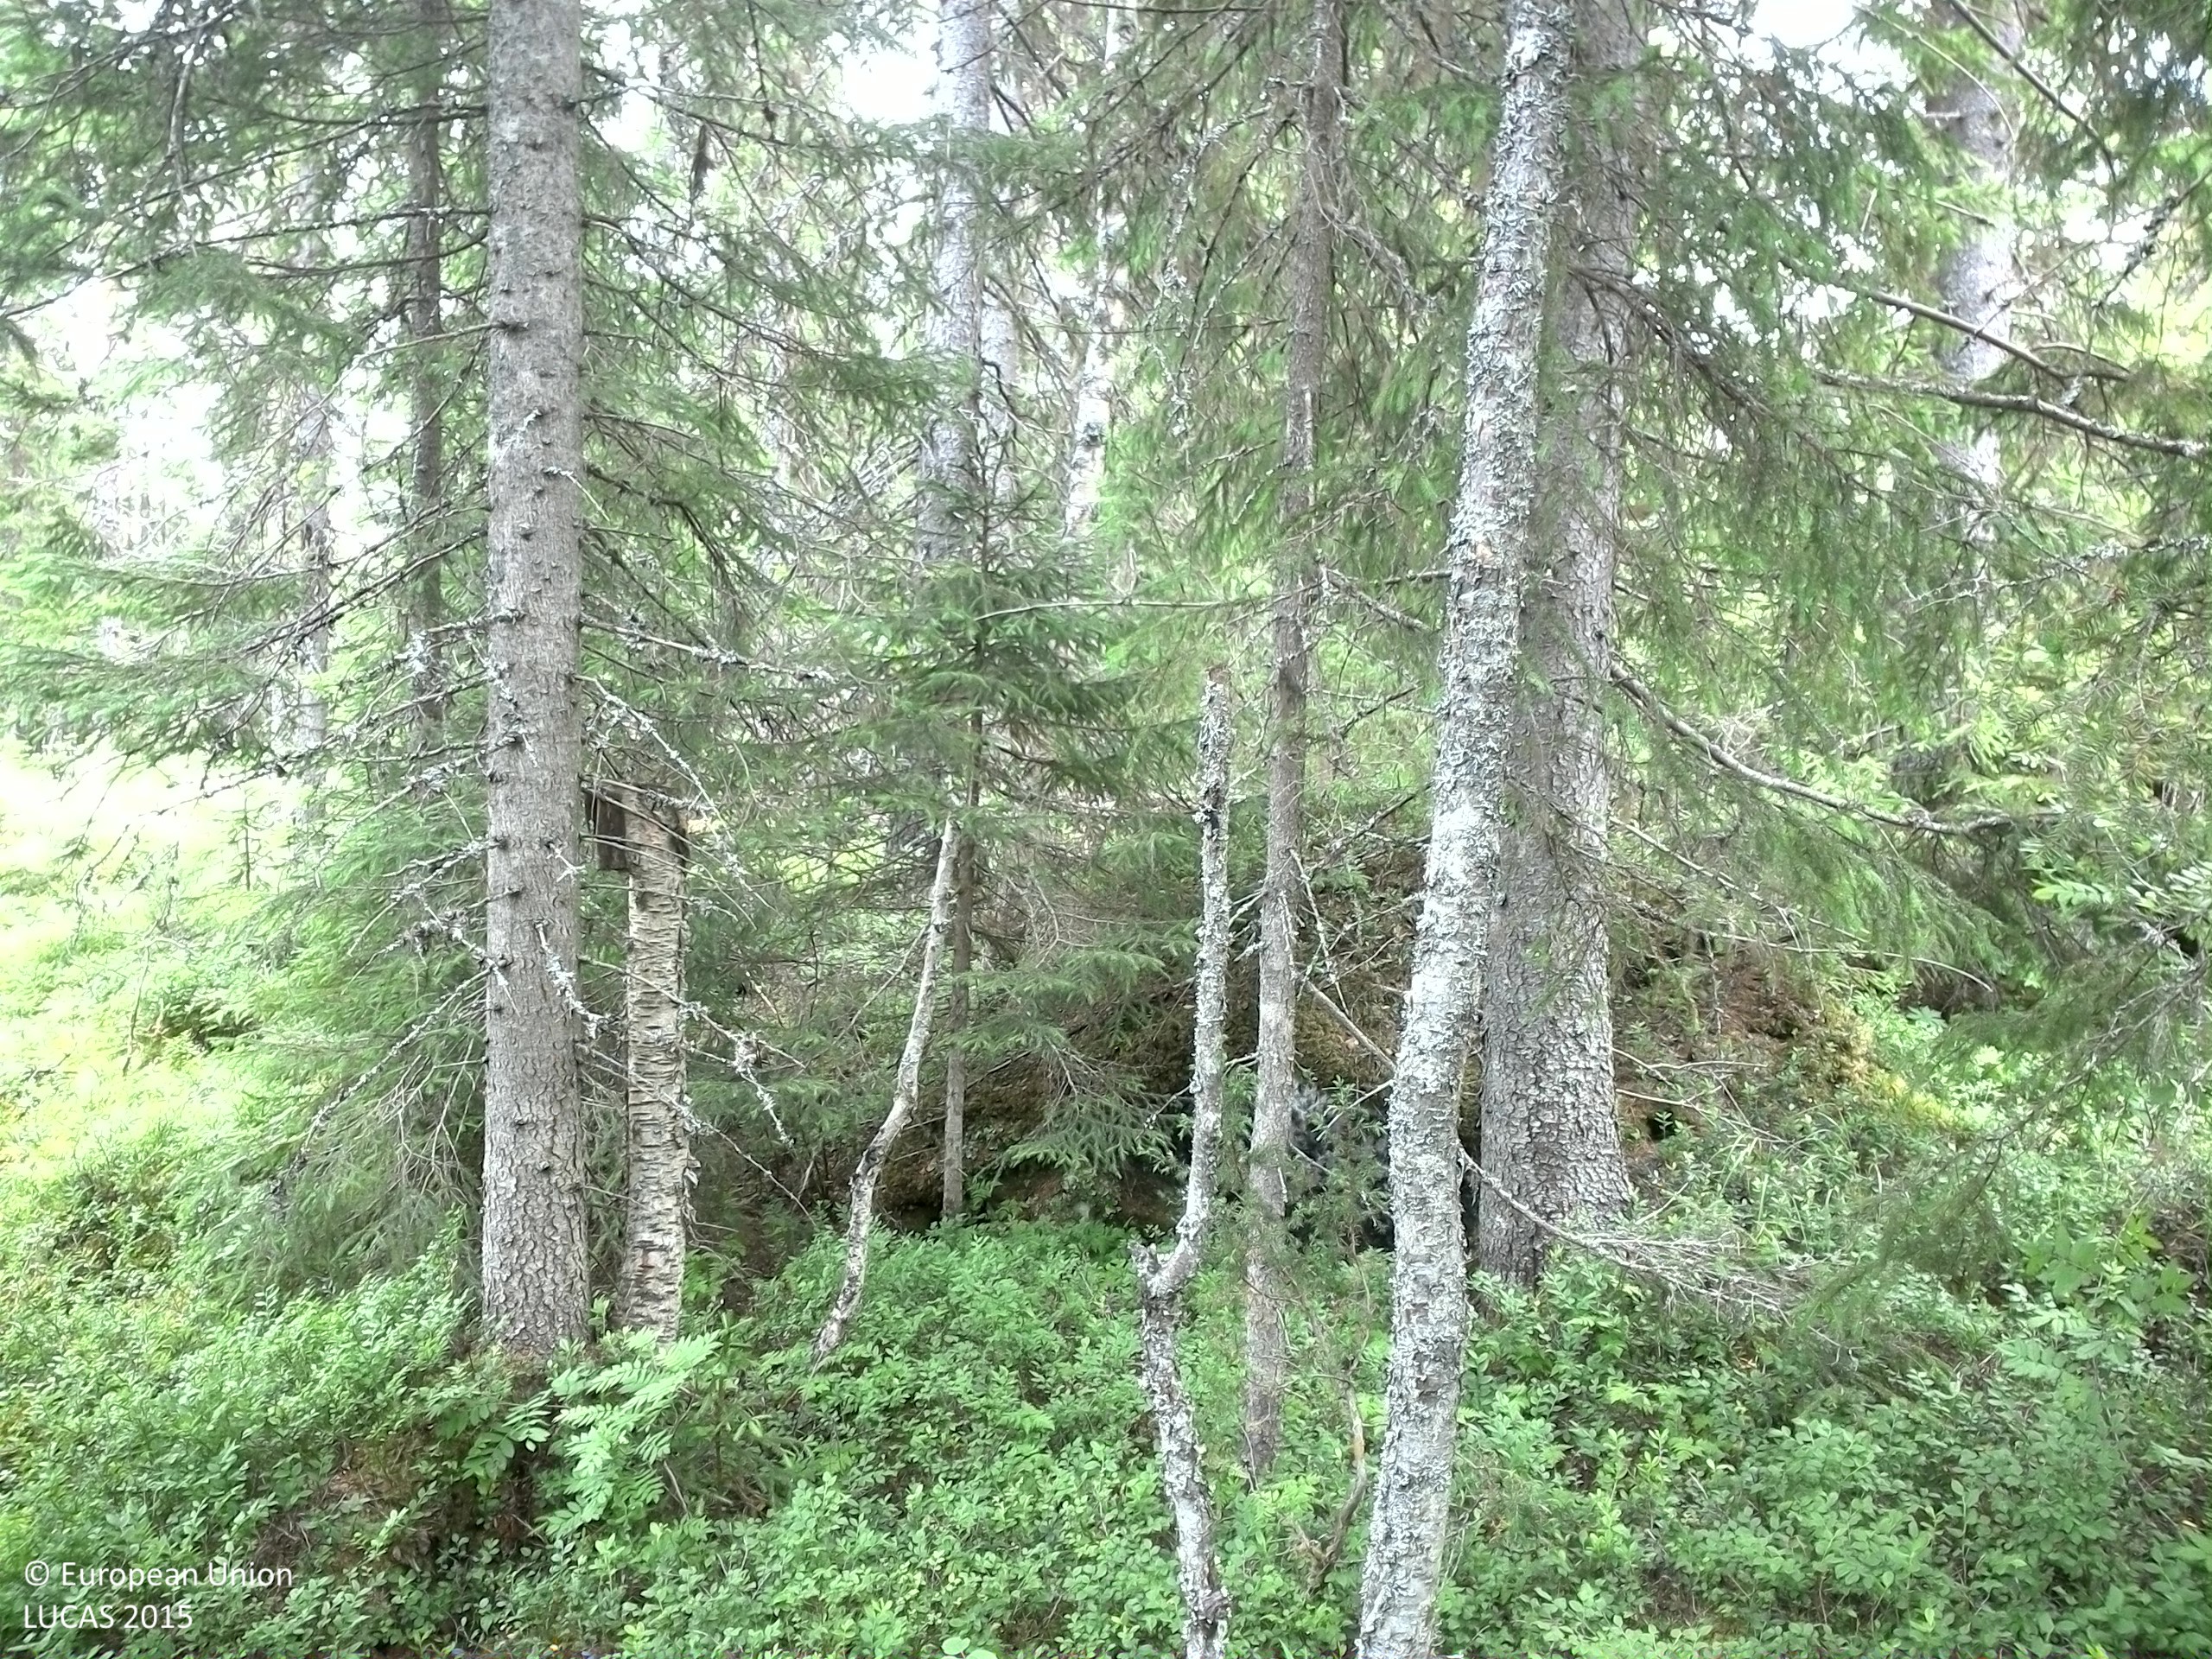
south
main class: Woodland
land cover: Spruce dominated mixed woodland
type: boreal forest
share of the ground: > 75 %
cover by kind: coniferous forest trees 60 %, broadleaved forest trees 20 %, shrubs 20 %
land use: Forestry
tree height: > 5 m
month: July
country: SE
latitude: 62.7622
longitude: 17.2833
